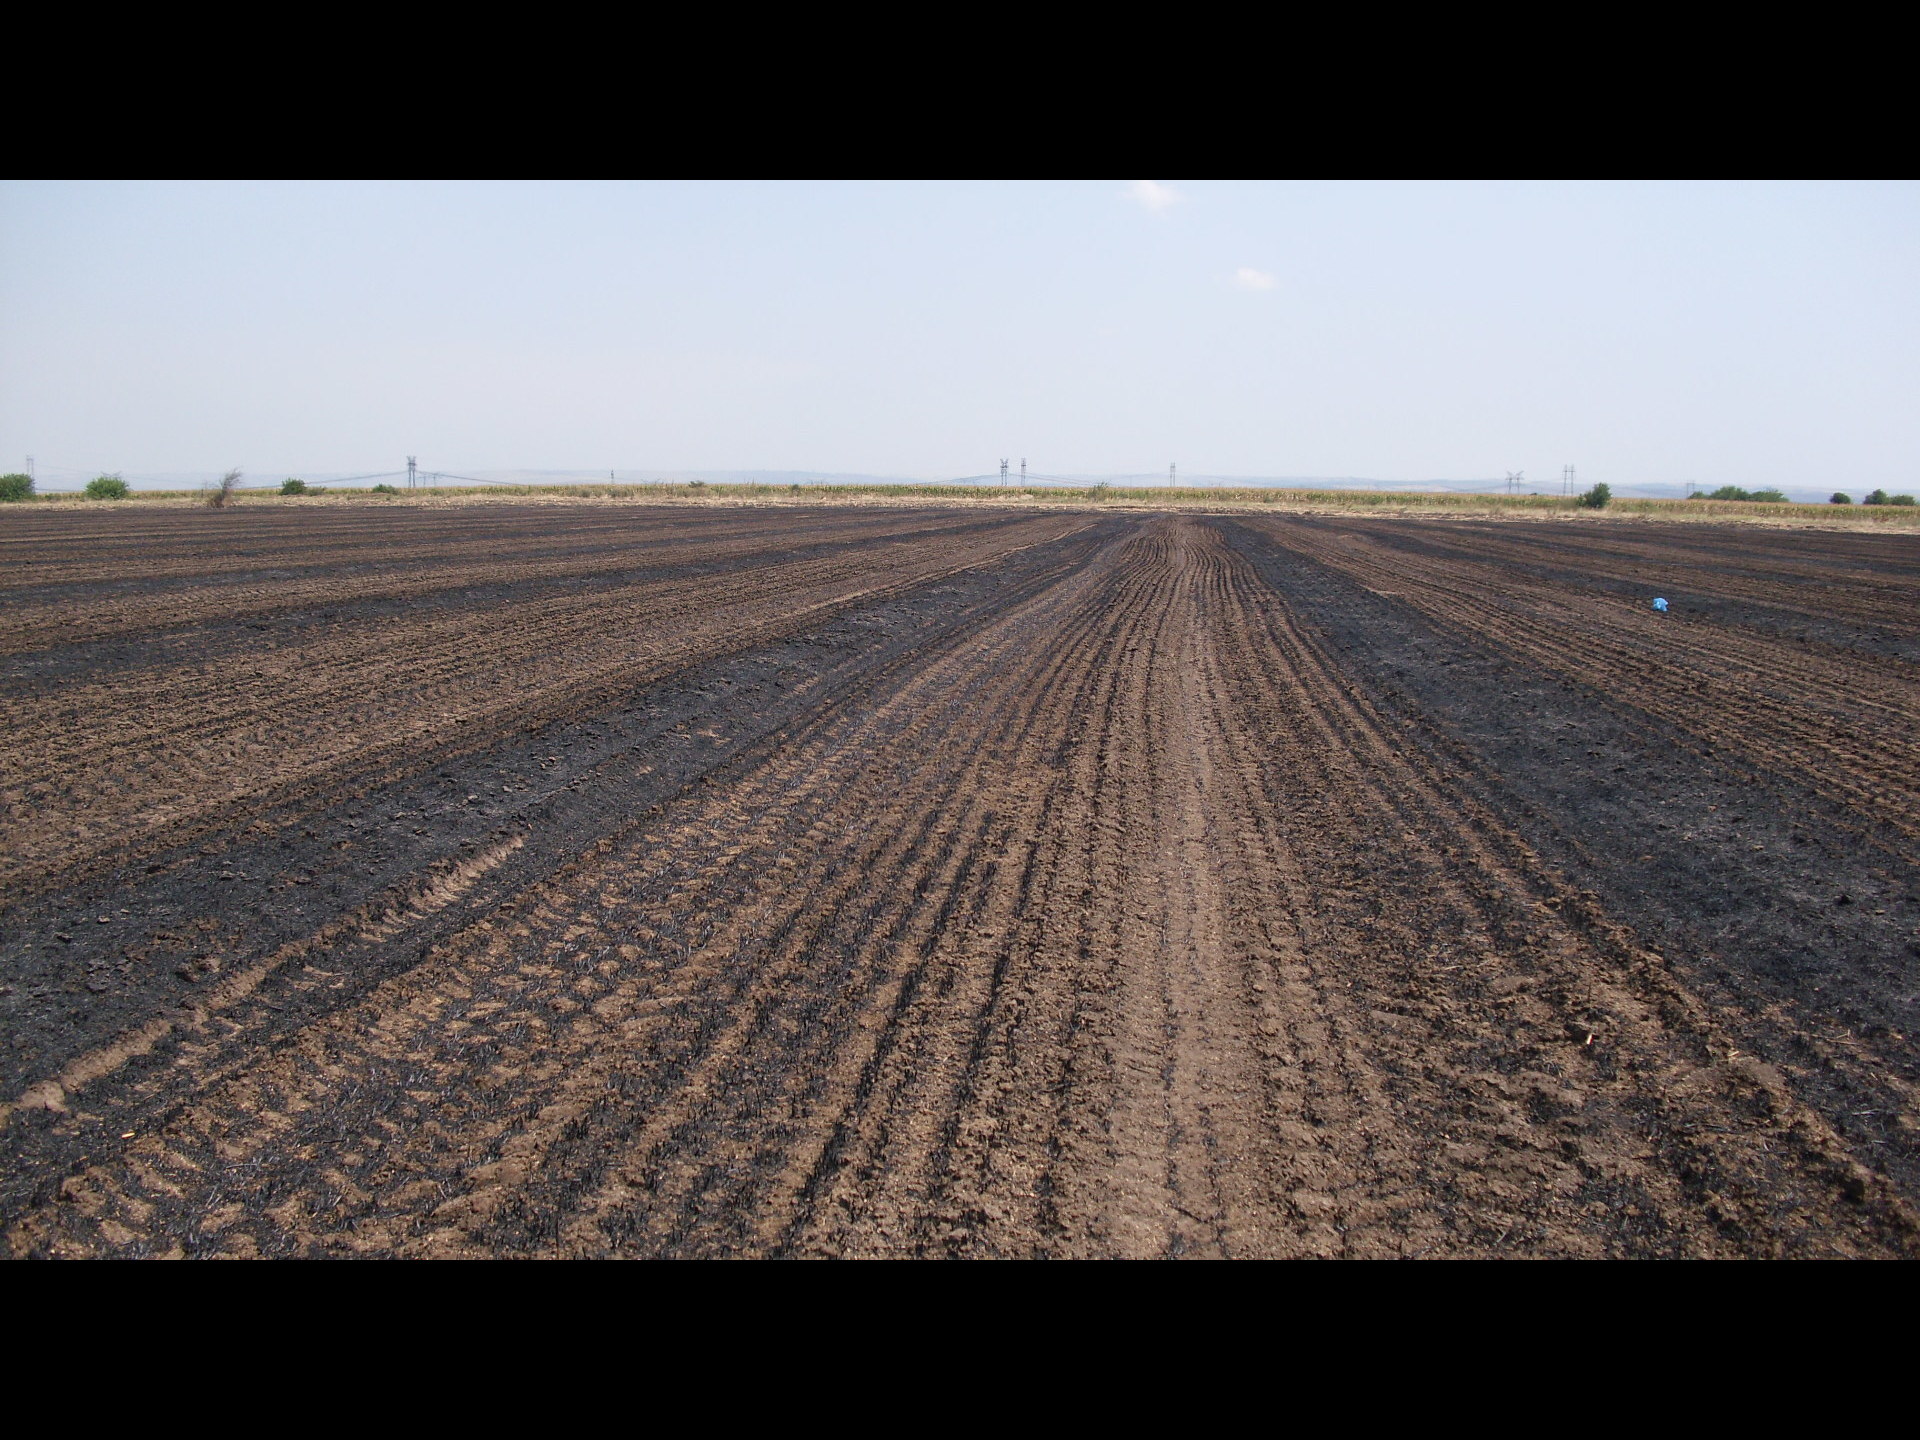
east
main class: Cropland
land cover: Common wheat
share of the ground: < 10 %
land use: Agriculture (excluding fallow land and kitchen gardens)
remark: Burnt area
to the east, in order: Common wheat; Tracks; Grassland without tree/shrub cover; Ditches and canals; Grassland with sparse tree/shrub cover; Maize
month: August
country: BG
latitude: 43.7092
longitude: 23.7138
